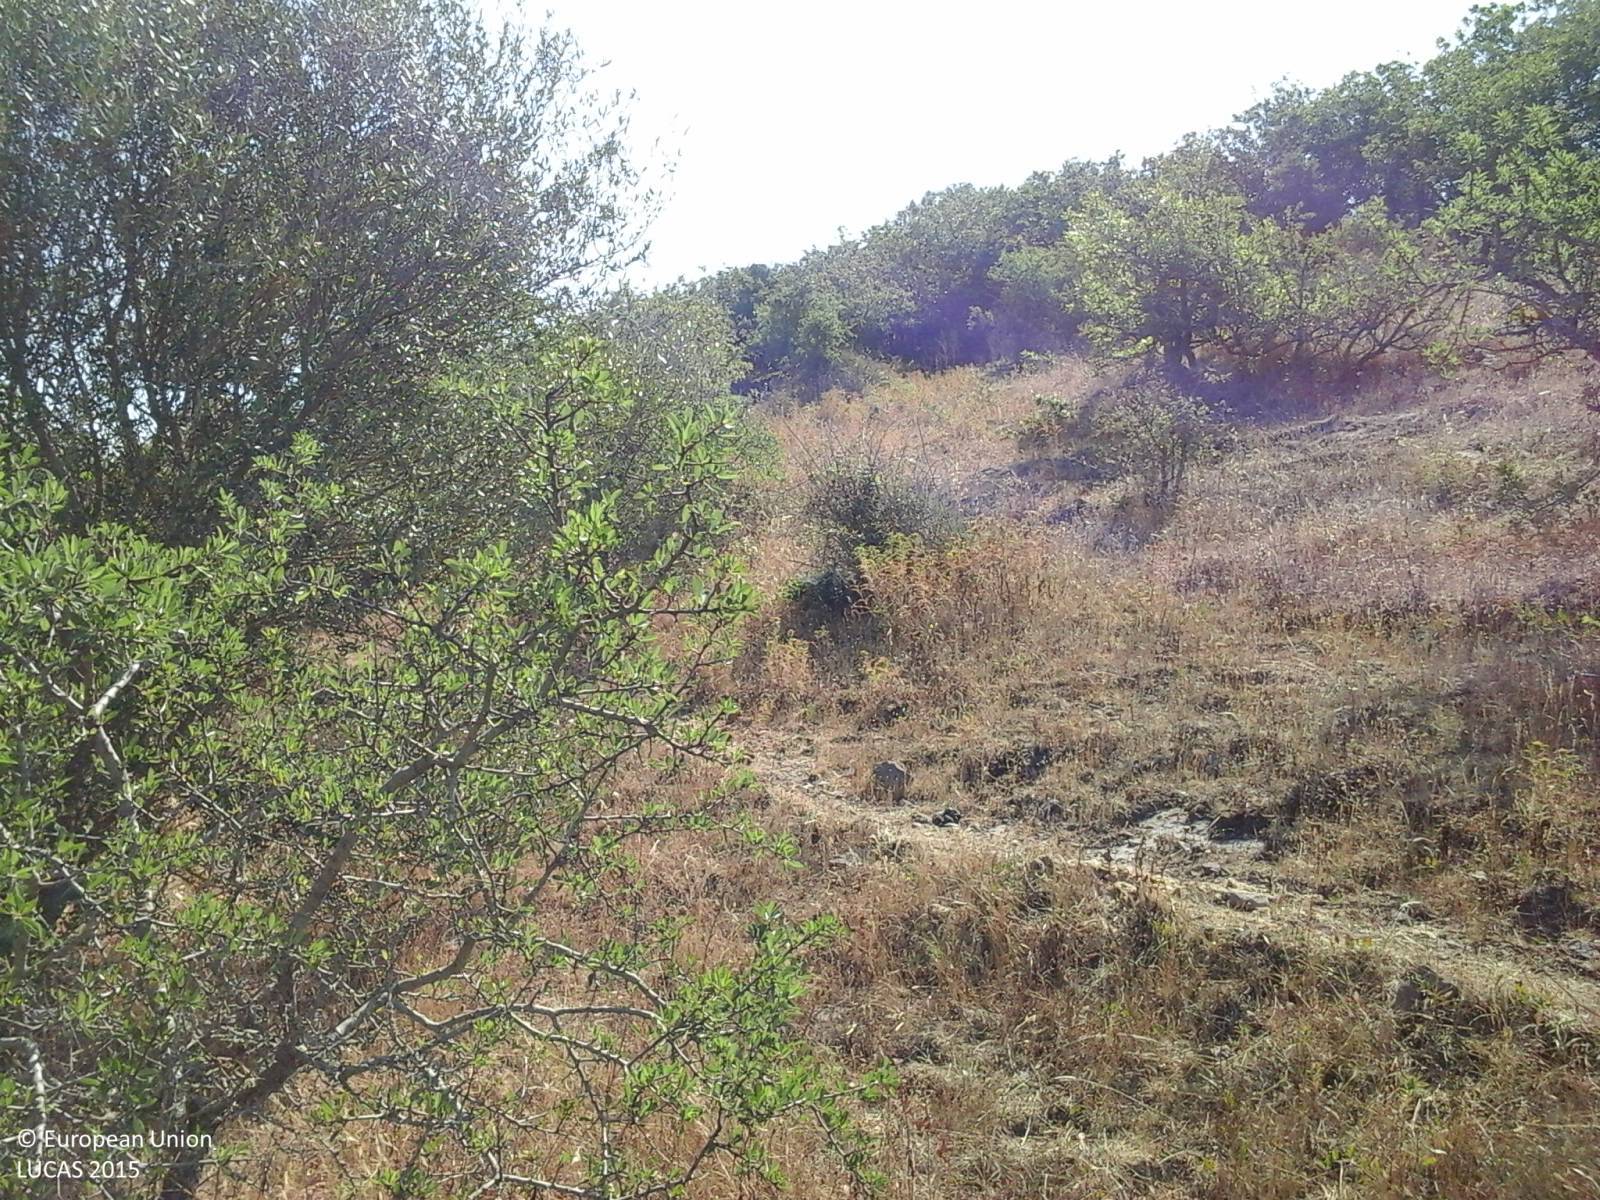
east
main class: Woodland
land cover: Broadleaved woodland
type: broadleaved evergreen forest
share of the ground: 10 - 25 %
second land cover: Grassland without tree/shrub cover
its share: 25 - 50 %
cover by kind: herbaceous plants 65 %, broadleaved forest trees 25 %, shrubs 10 %
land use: Forestry
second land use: Agriculture (excluding fallow land and kitchen gardens)
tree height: > 5 m
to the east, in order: Broadleaved woodland; Grassland without tree/shrub cover; Broadleaved woodland; Dry stone walls; Fences; Grassland with sparse tree/shrub cover; Broadleaved woodland; Ditches and canals; Broadleaved woodland
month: July
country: IT
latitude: 40.5272
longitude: 8.4848
